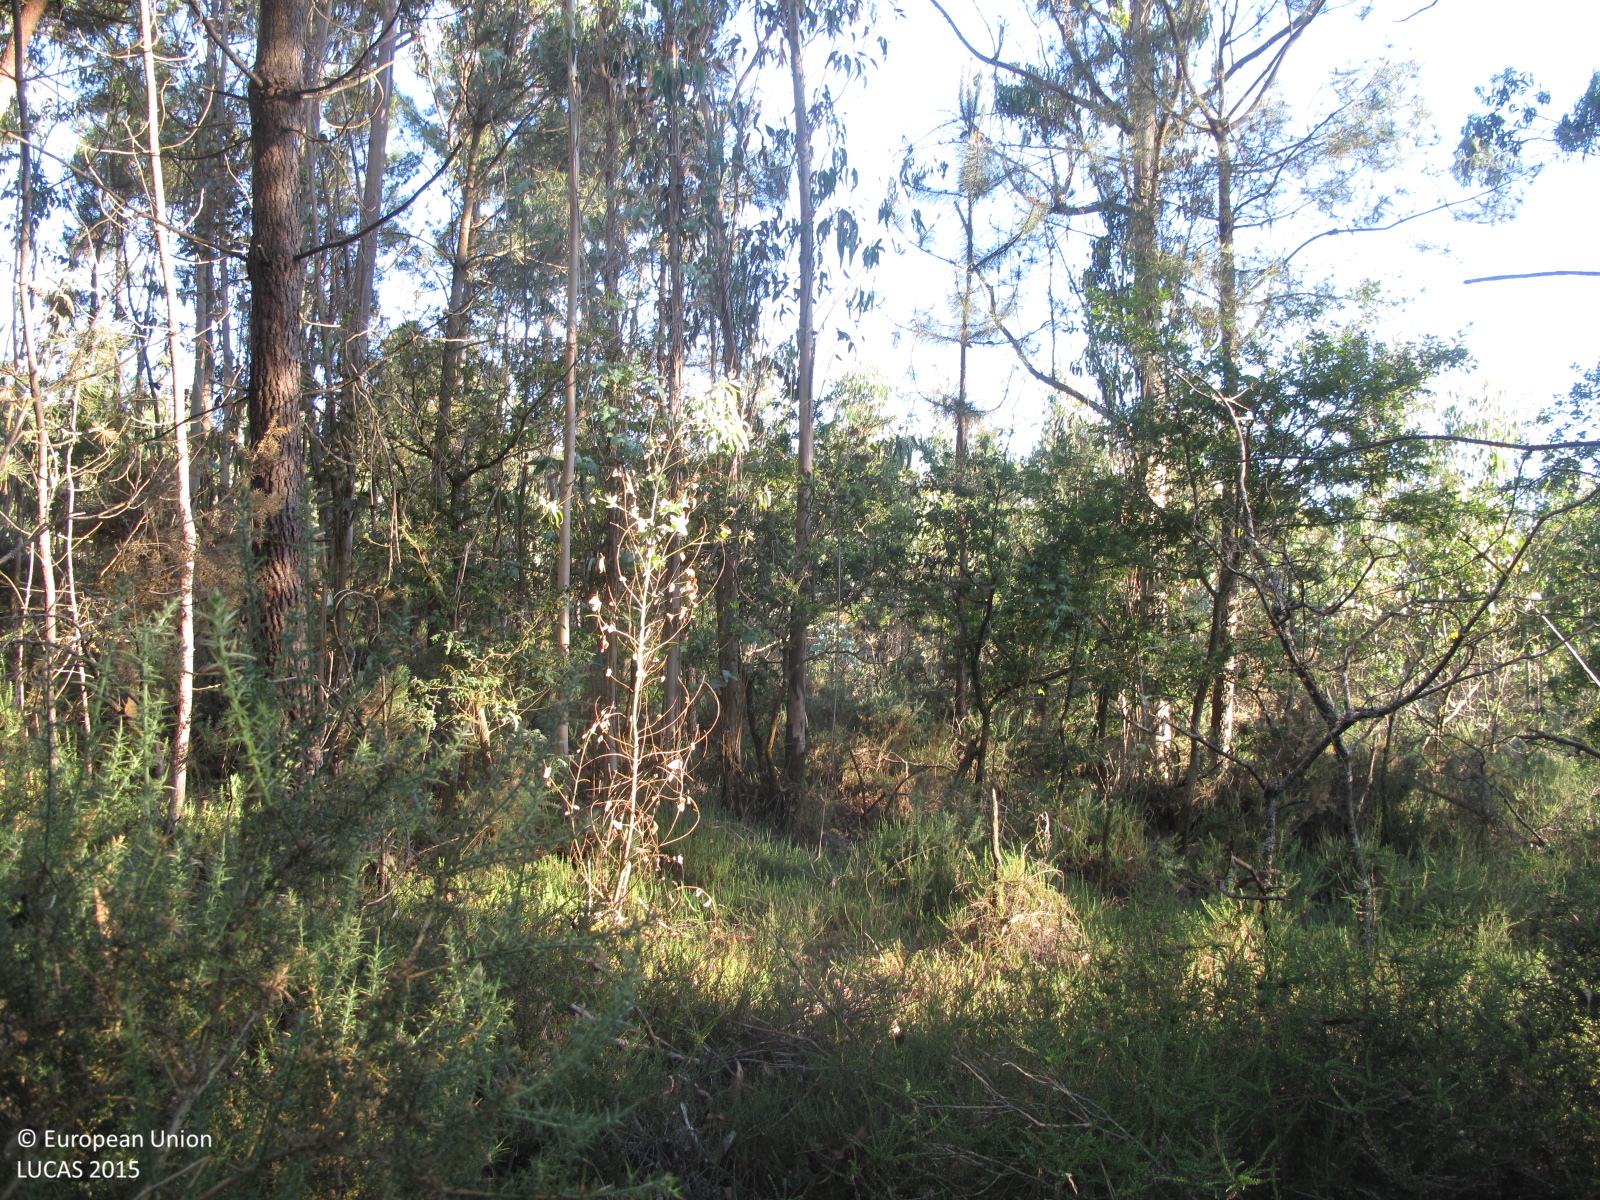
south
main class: Woodland
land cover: Other mixed woodland
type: exotic forest
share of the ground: 50 - 75 %
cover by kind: broadleaved forest trees 40 %, coniferous forest trees 30 %, shrubs 20 %, herbaceous plants 10 %
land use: Forestry
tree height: > 5 m
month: June
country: ES
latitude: 42.9720
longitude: -8.5596
